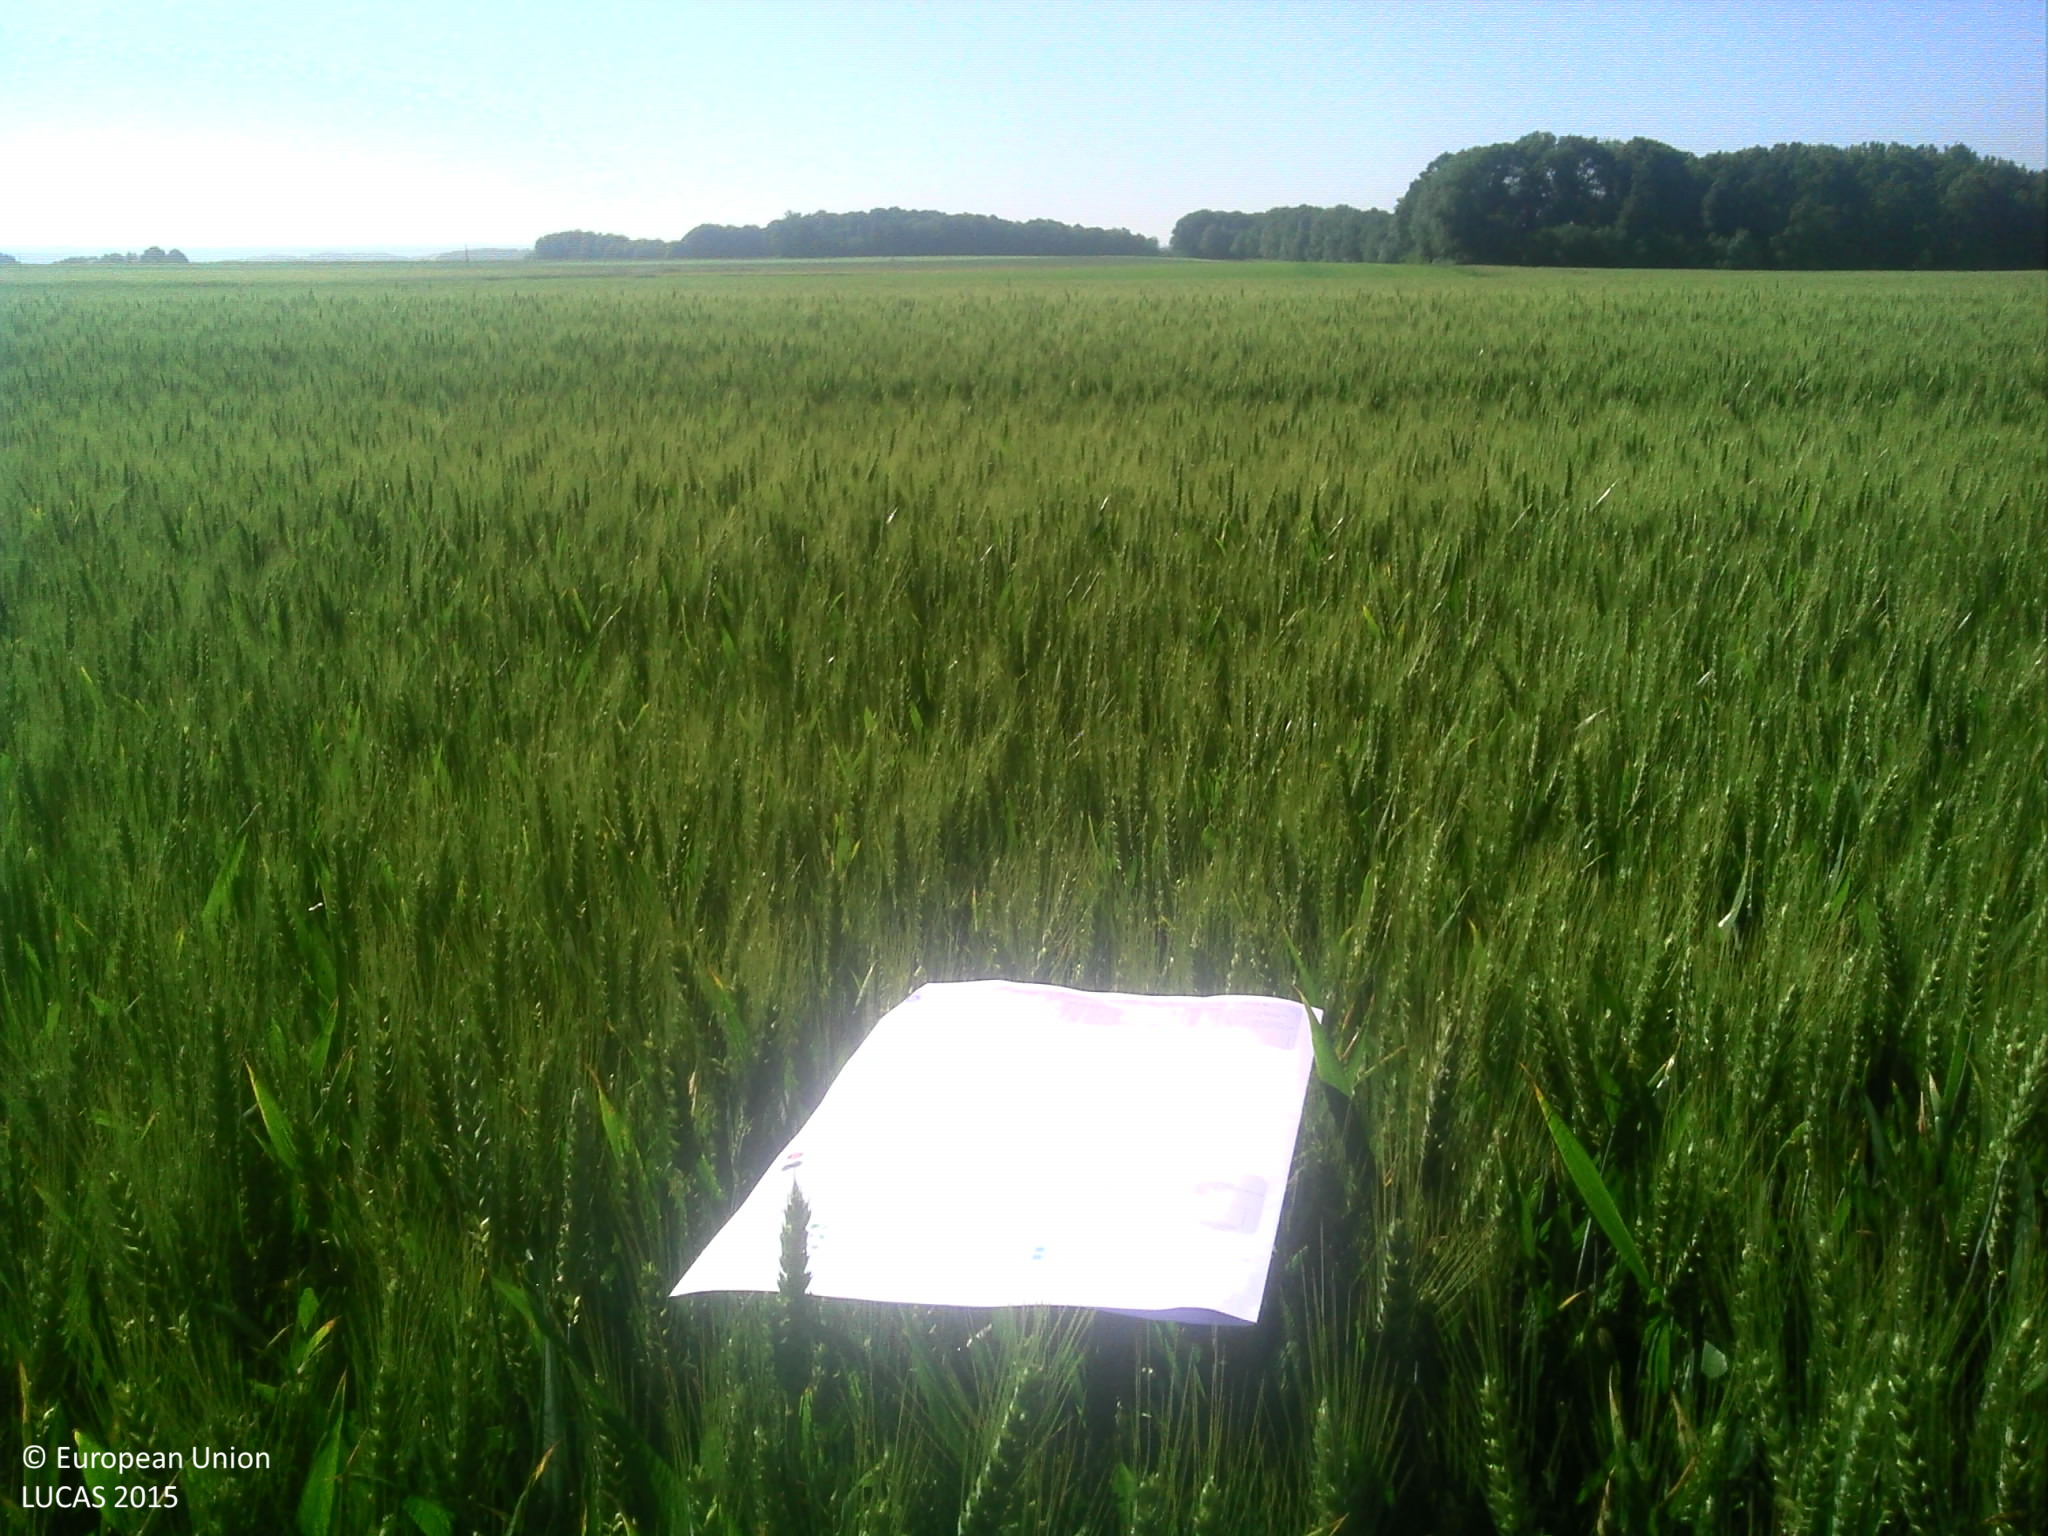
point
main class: Cropland
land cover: Common wheat
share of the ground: > 75 %
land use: Agriculture (excluding fallow land and kitchen gardens)
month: June
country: FR
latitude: 48.4585
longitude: 4.7376
